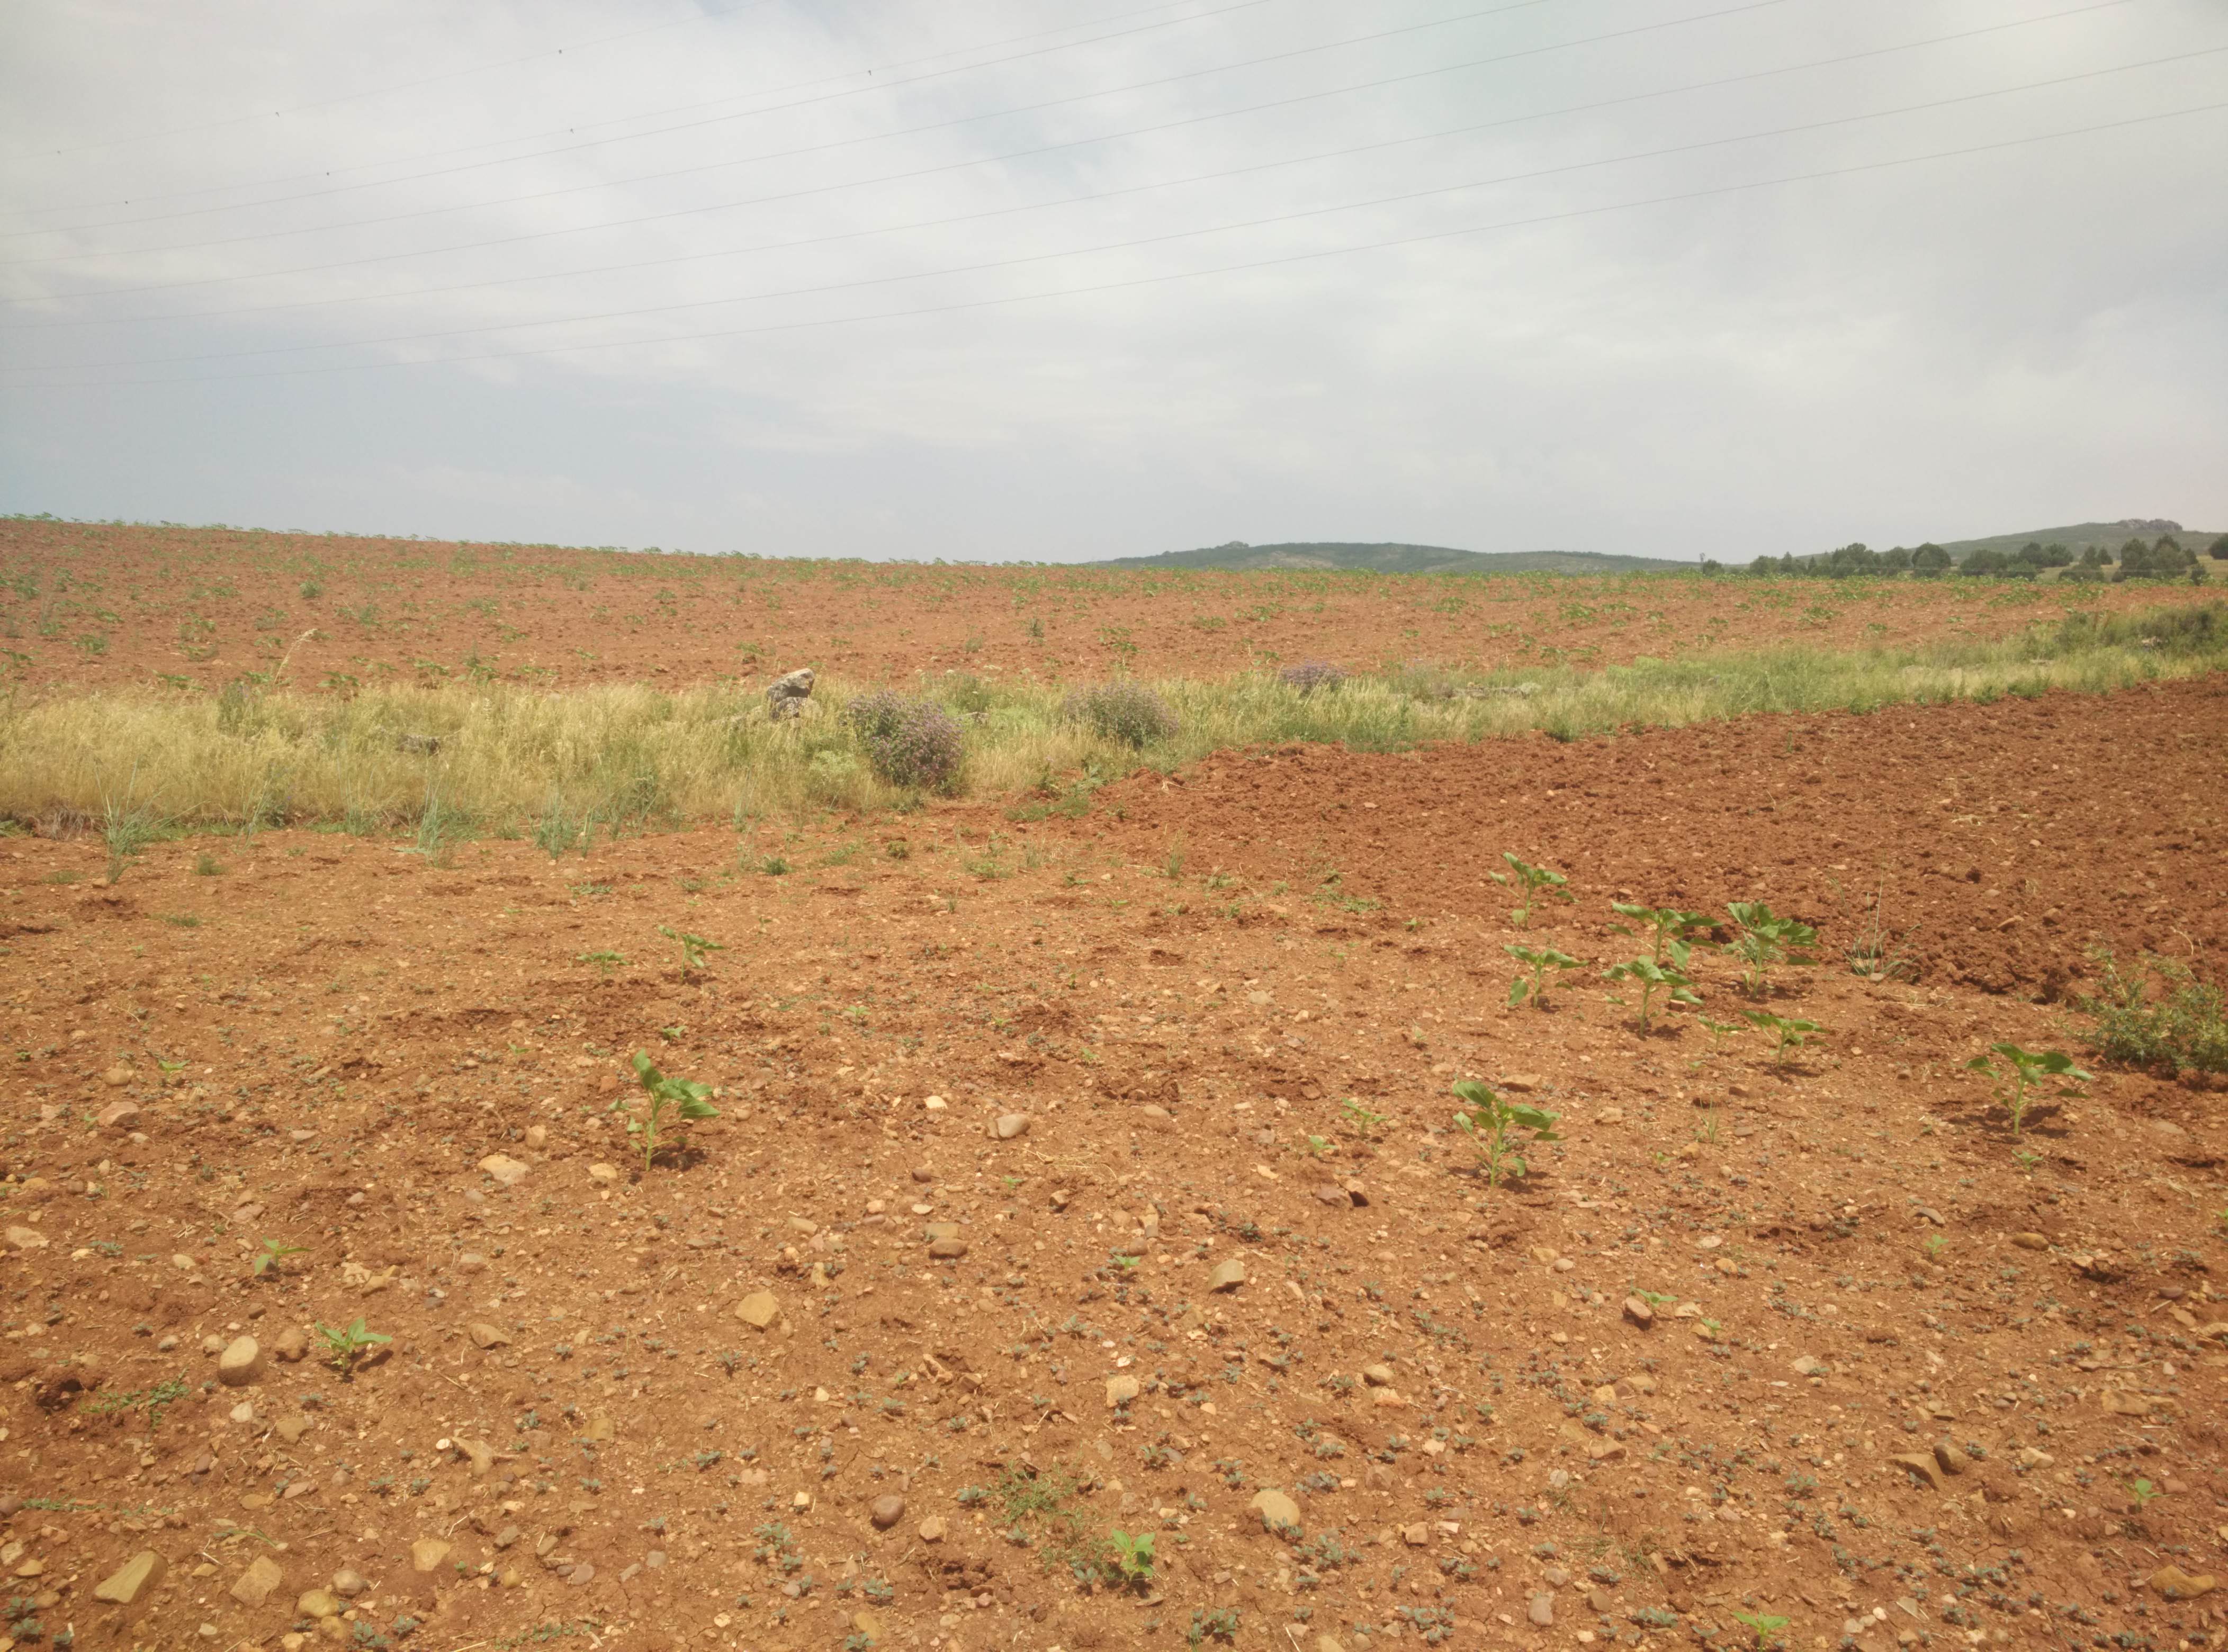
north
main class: Cropland
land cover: Sunflower
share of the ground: < 10 %
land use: Agriculture (excluding fallow land and kitchen gardens)
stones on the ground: < 10 %
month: July
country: ES
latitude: 40.9276
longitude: -2.0546
